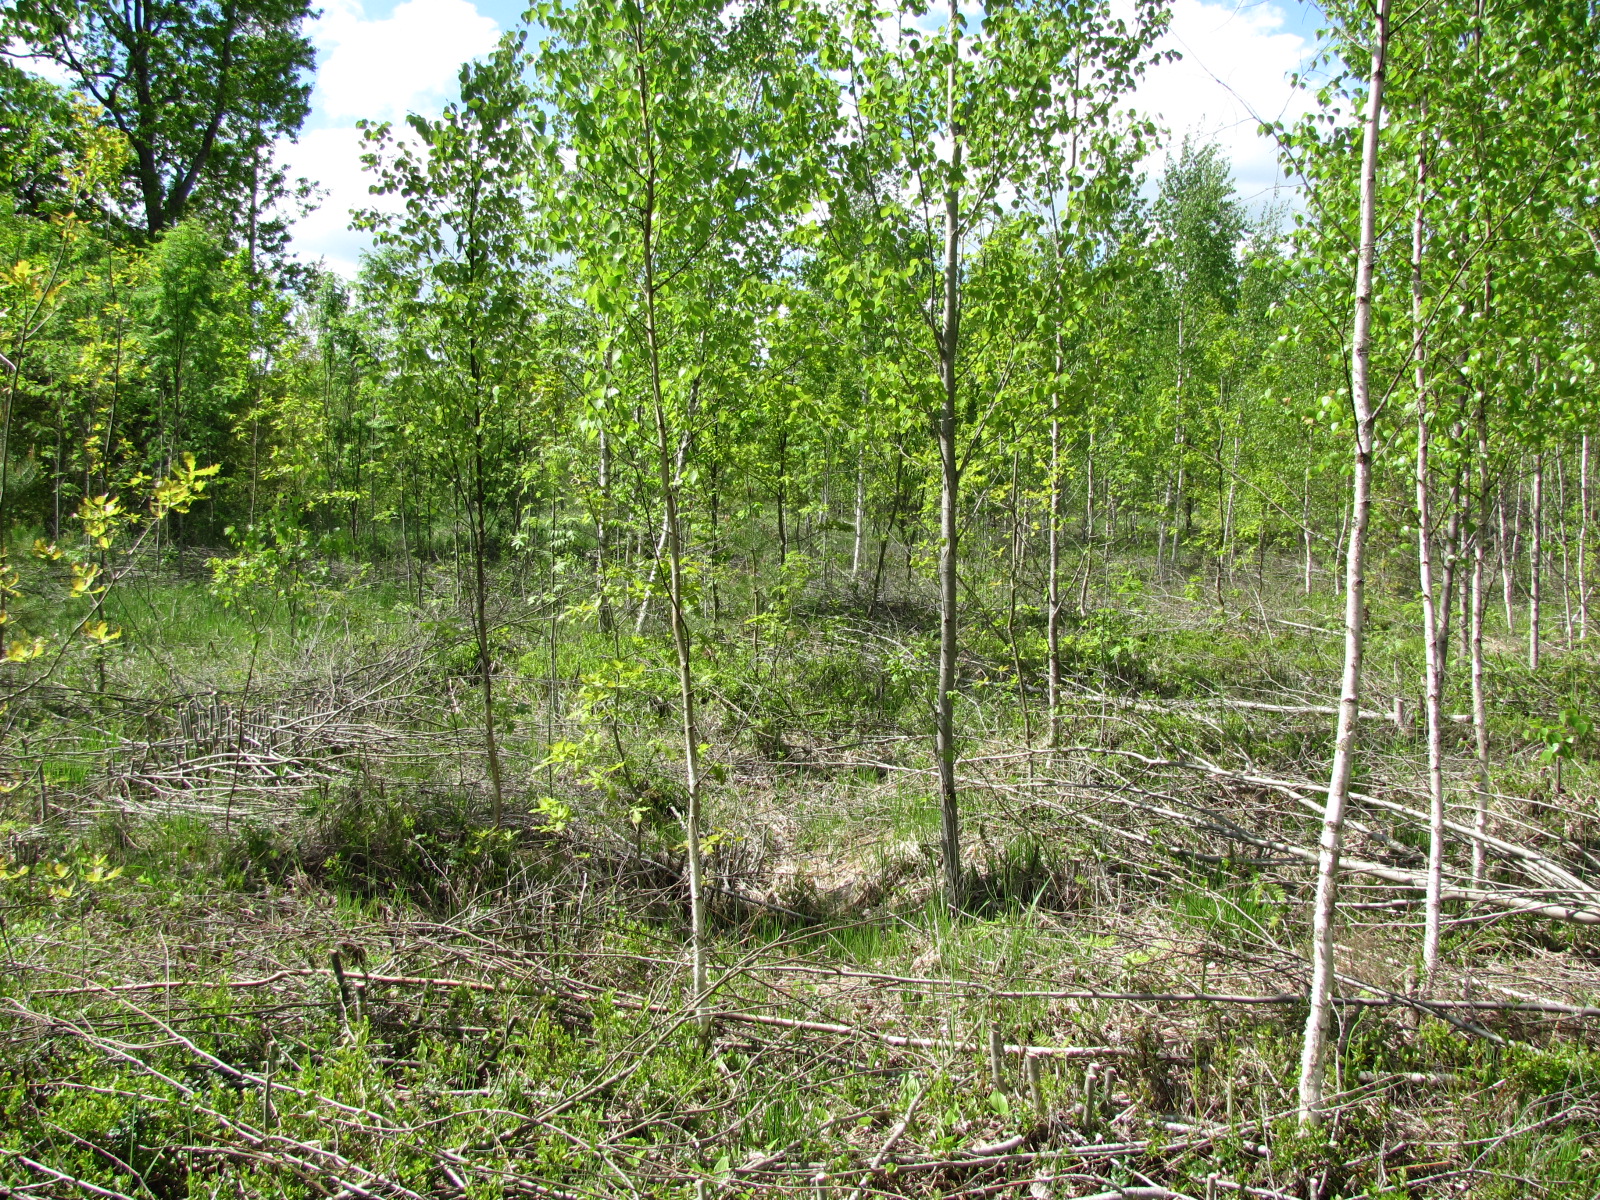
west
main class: Woodland
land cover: Broadleaved woodland
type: non-riverine alder, birch or aspen forest
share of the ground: 50 - 75 %
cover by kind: broadleaved forest trees 60 %, herbaceous plants 40 %
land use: Forestry
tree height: > 5 m
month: May
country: LV
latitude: 56.6478
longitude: 23.9292
